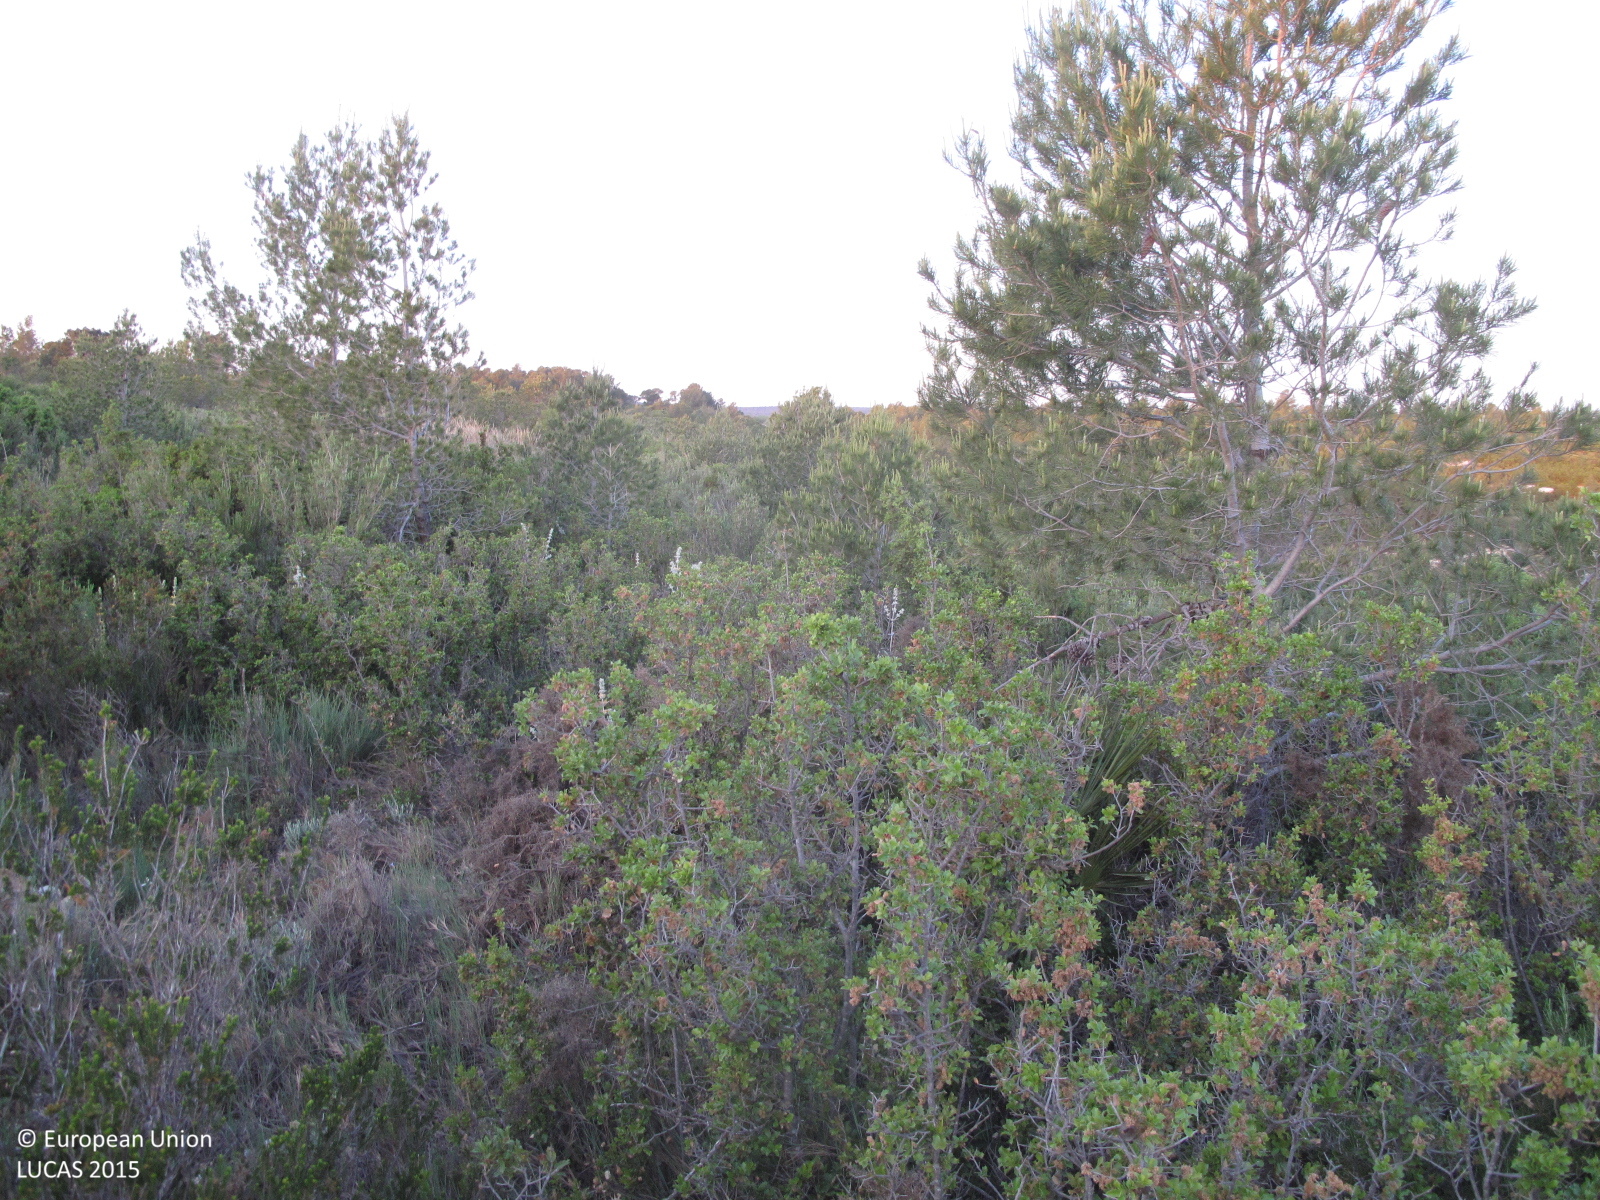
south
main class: Woodland
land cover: Pine dominated coniferous woodland
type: coniferous forest of the mediterranean region
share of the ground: 25 - 50 %
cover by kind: coniferous forest trees 40 %, shrubs 20 %, herbaceous plants 20 %, consolidated bare surface 20 %
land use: Semi-natural and natural areas not in use
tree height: < 5 m
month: May
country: ES
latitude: 39.0491
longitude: -0.7983
